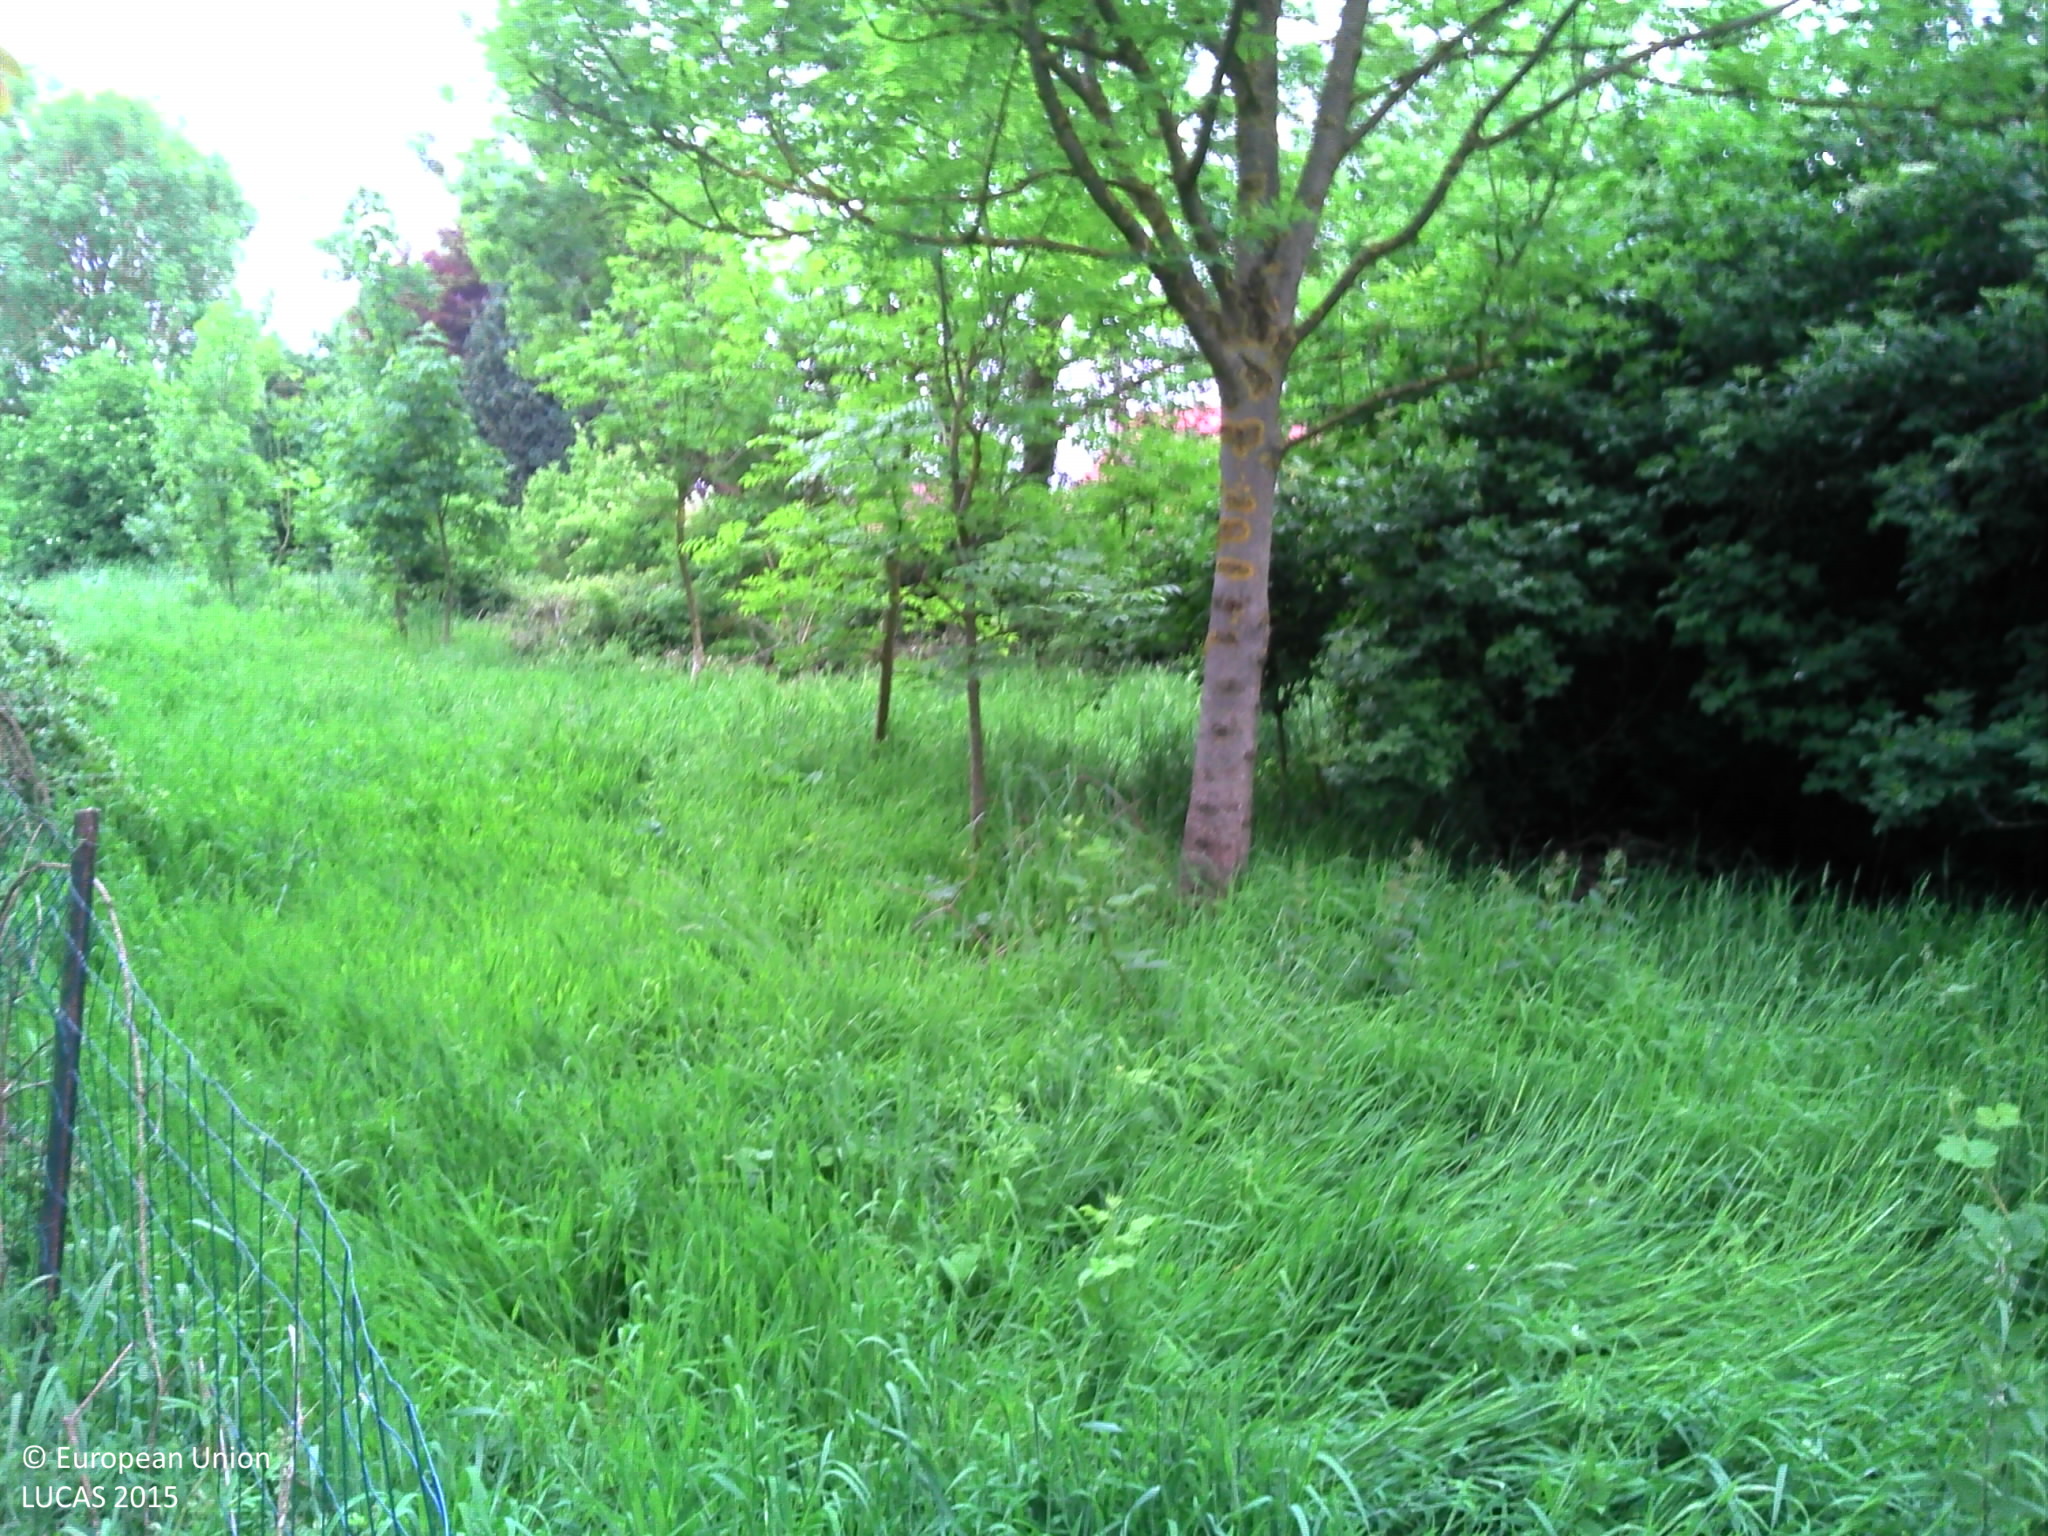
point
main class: Woodland
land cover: Broadleaved woodland
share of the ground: 50 - 75 %
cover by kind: broadleaved forest trees 60 %, herbaceous plants 40 %
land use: Residential
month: May
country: FR
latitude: 50.6090
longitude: 2.2847
